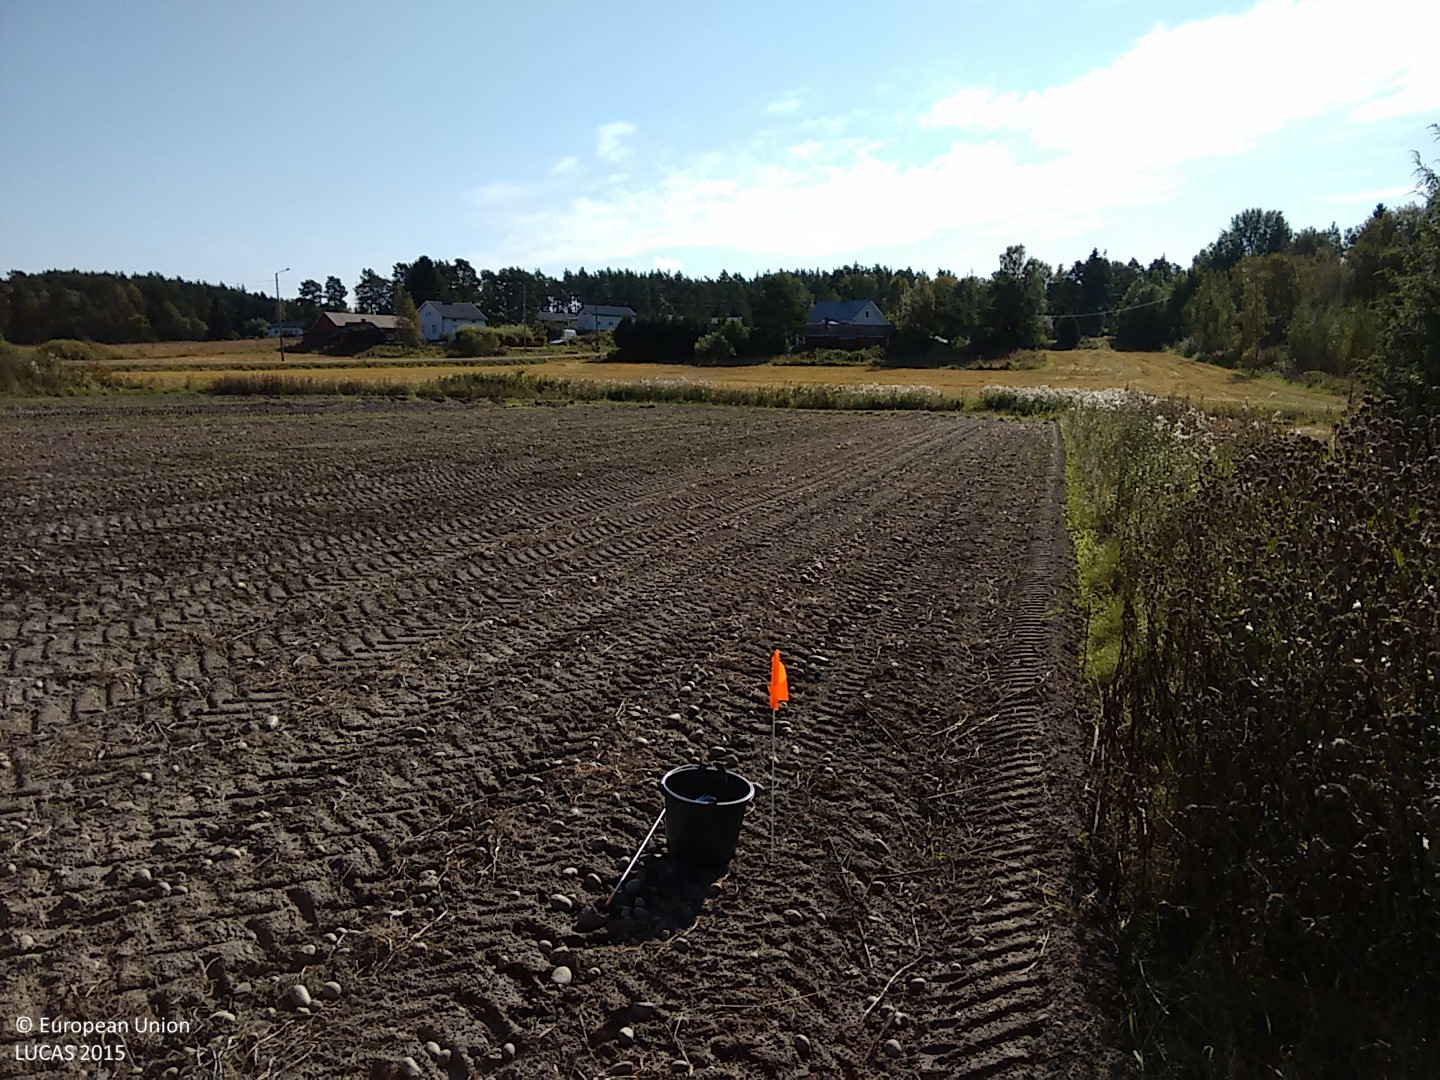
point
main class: Cropland
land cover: Potatoes
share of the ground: < 10 %
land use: Agriculture (excluding fallow land and kitchen gardens)
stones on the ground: < 10 %
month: September
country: FI
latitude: 60.9141
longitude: 21.6929
